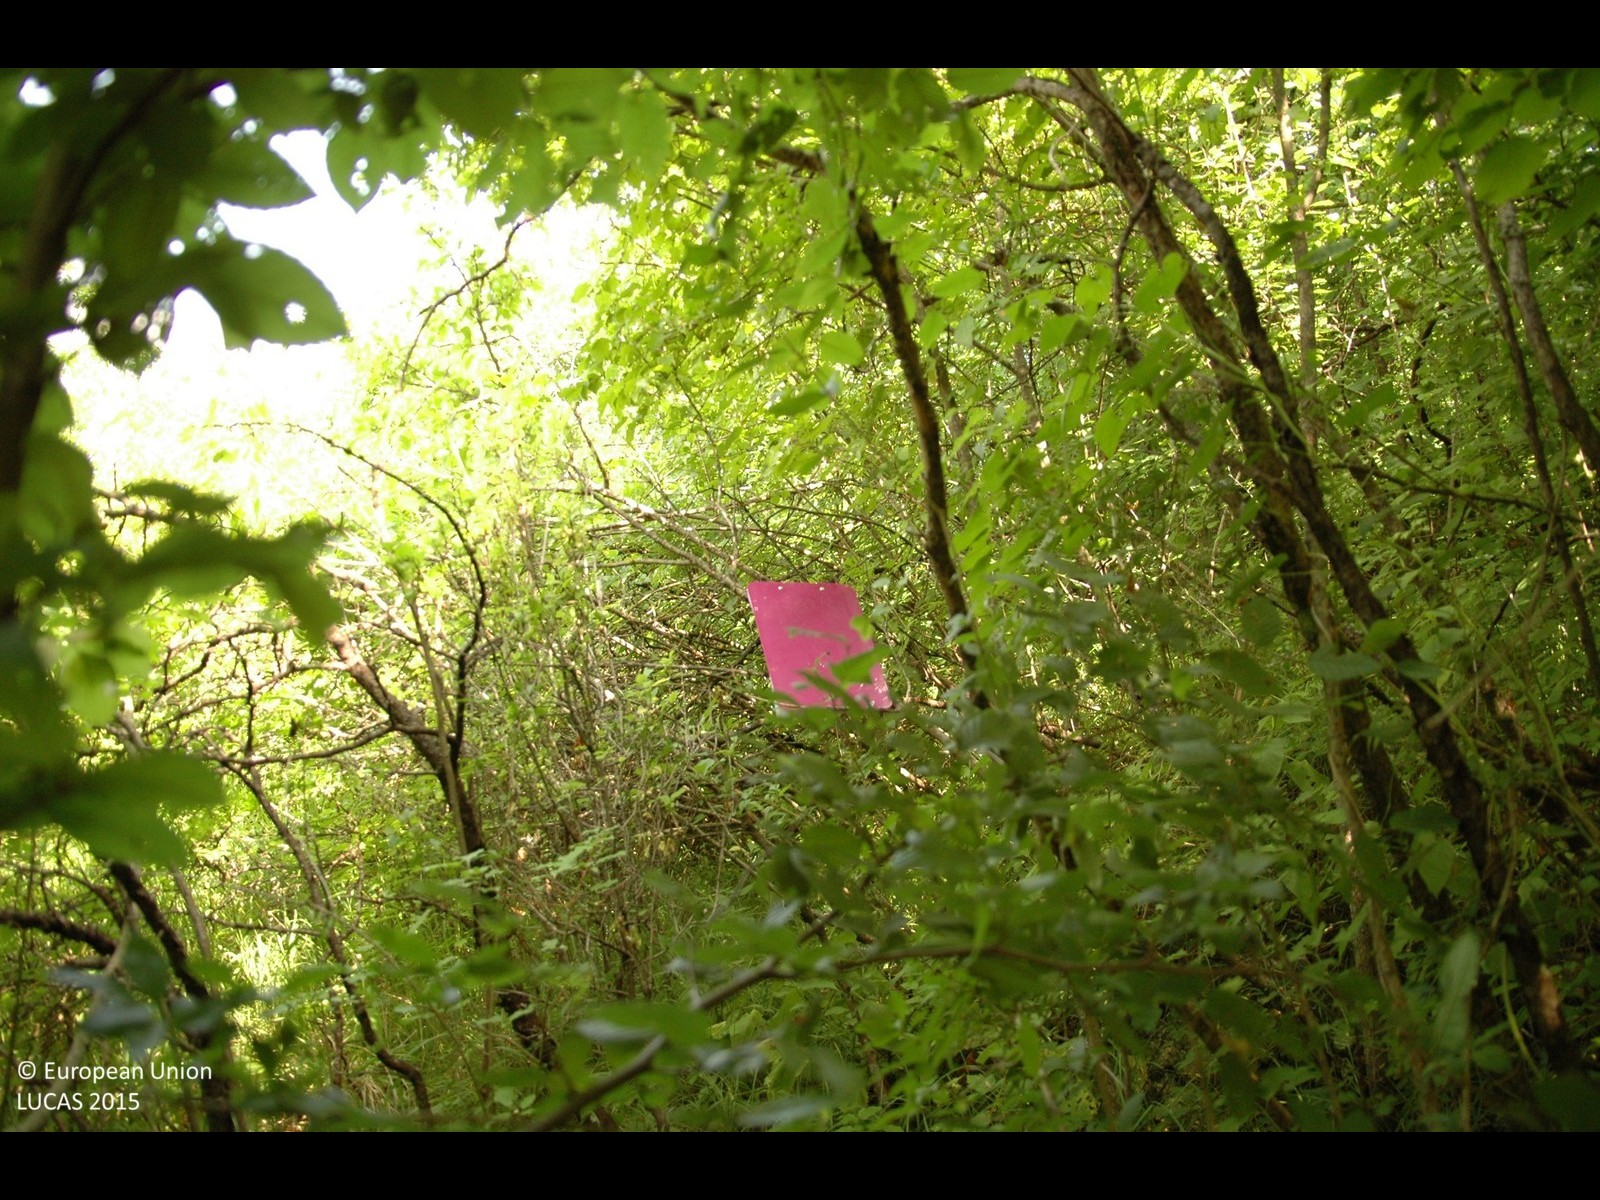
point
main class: Shrubland
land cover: Shrubland without tree cover
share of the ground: > 75 %
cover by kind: shrubs 100 %
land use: Semi-natural and natural areas not in use
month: July
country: HR
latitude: 46.1479
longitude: 16.5904
